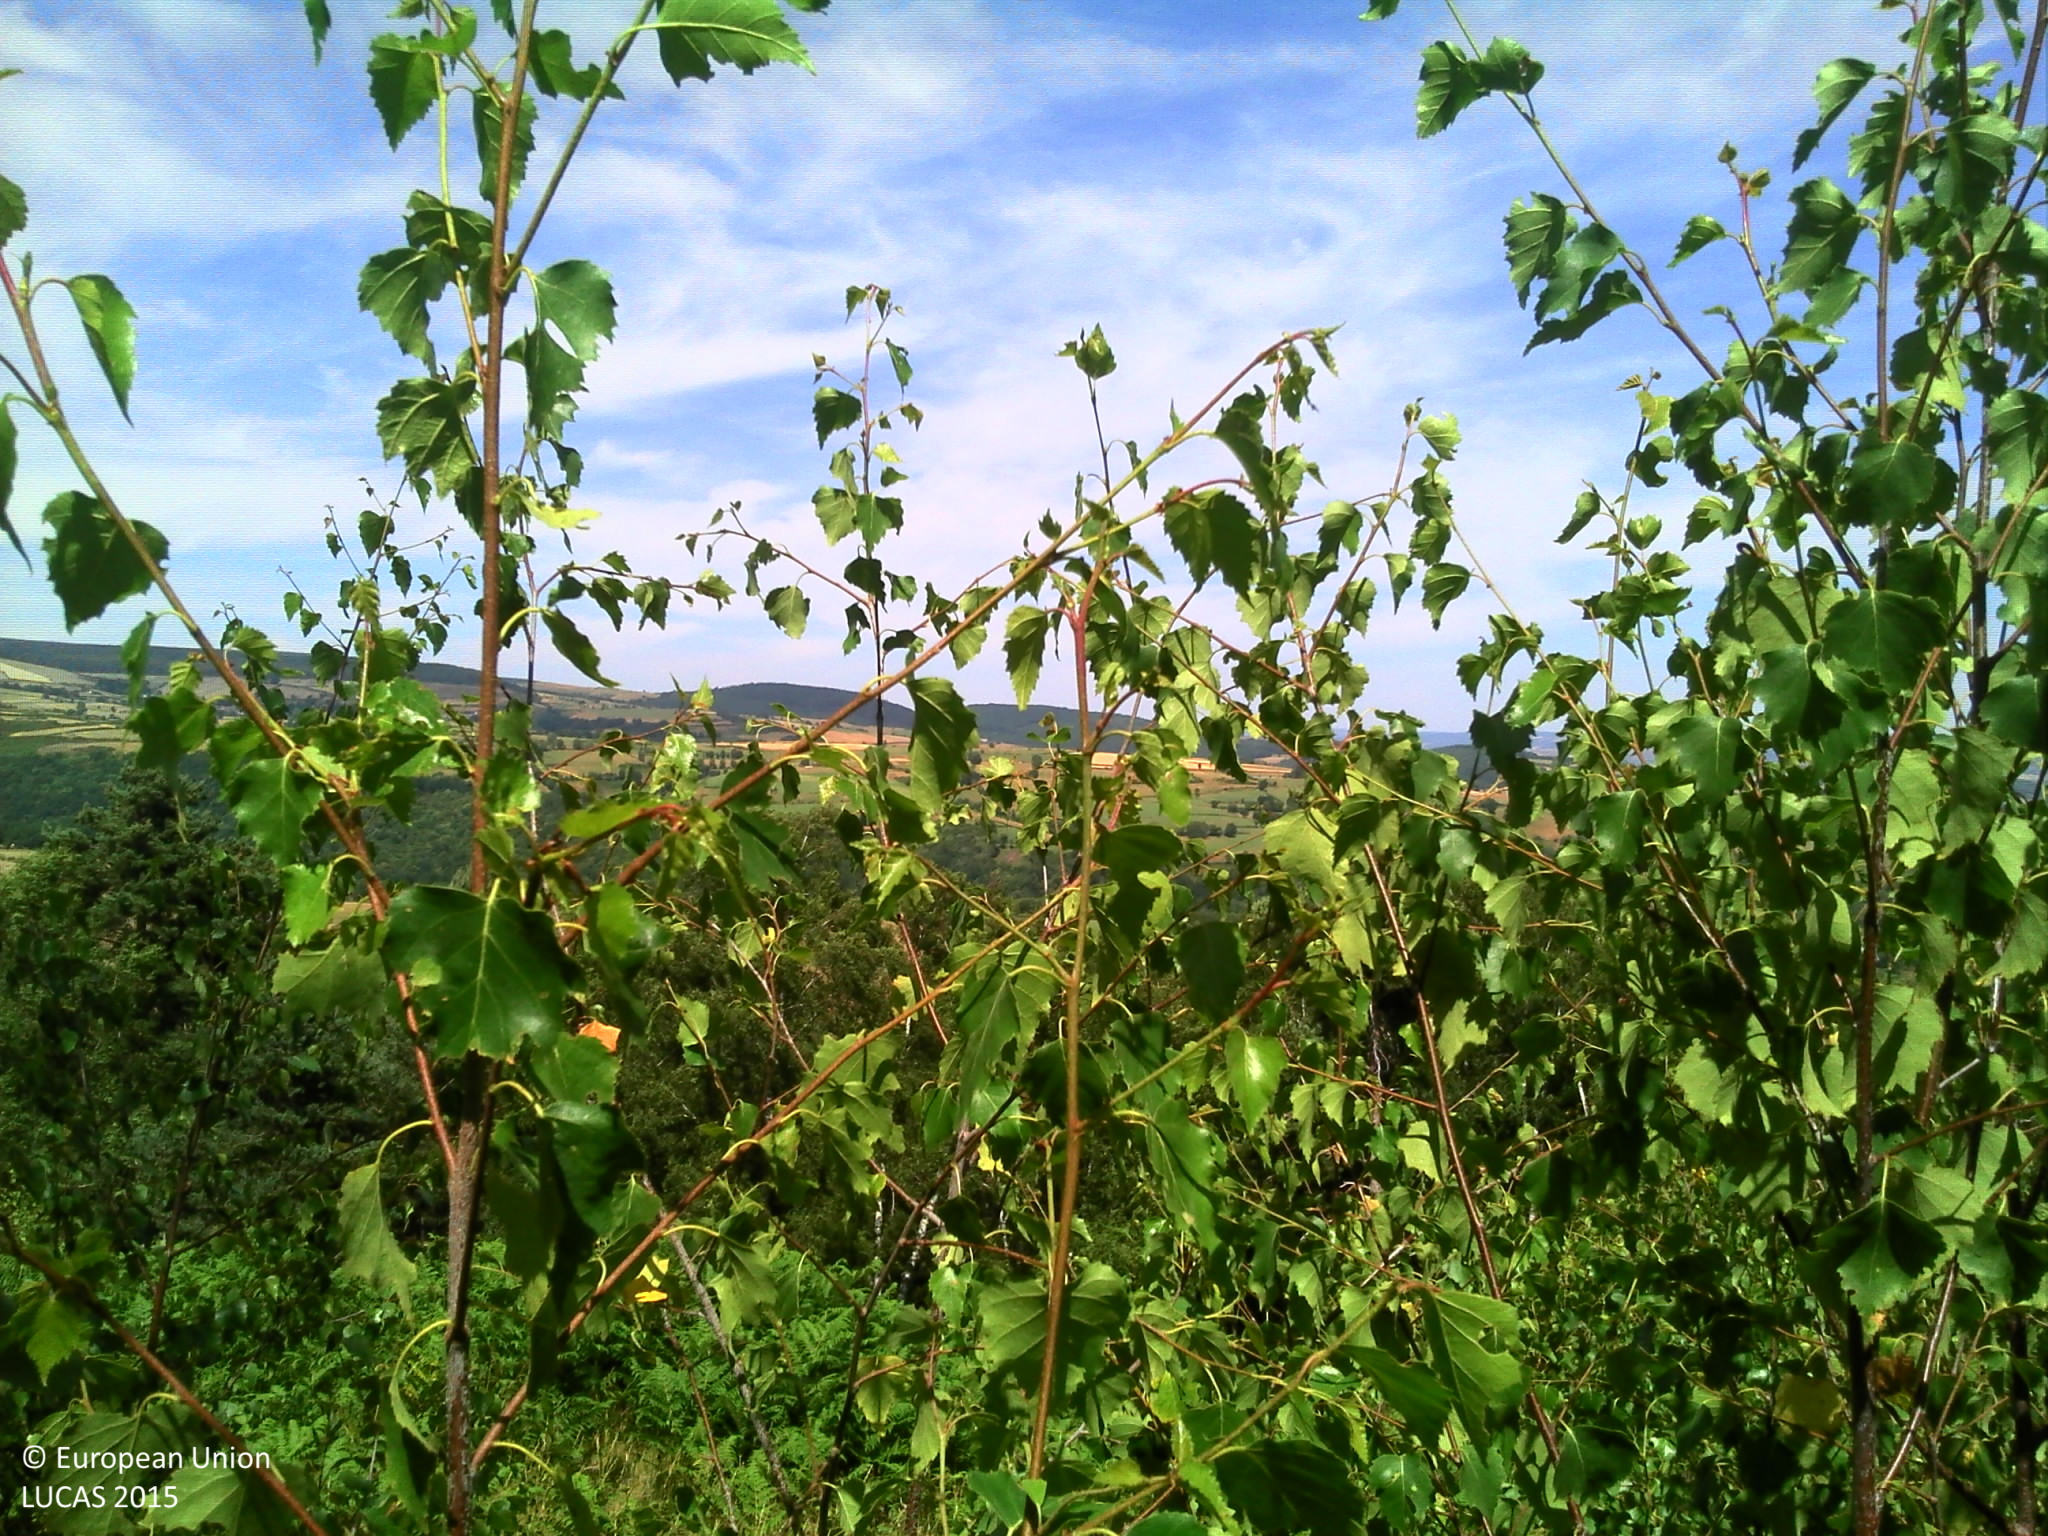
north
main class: Woodland
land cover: Broadleaved woodland
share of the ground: > 75 %
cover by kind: broadleaved forest trees 75 %, shrubs 15 %, herbaceous plants 10 %
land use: Forestry
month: July
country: FR
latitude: 44.4828
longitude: 3.1017
